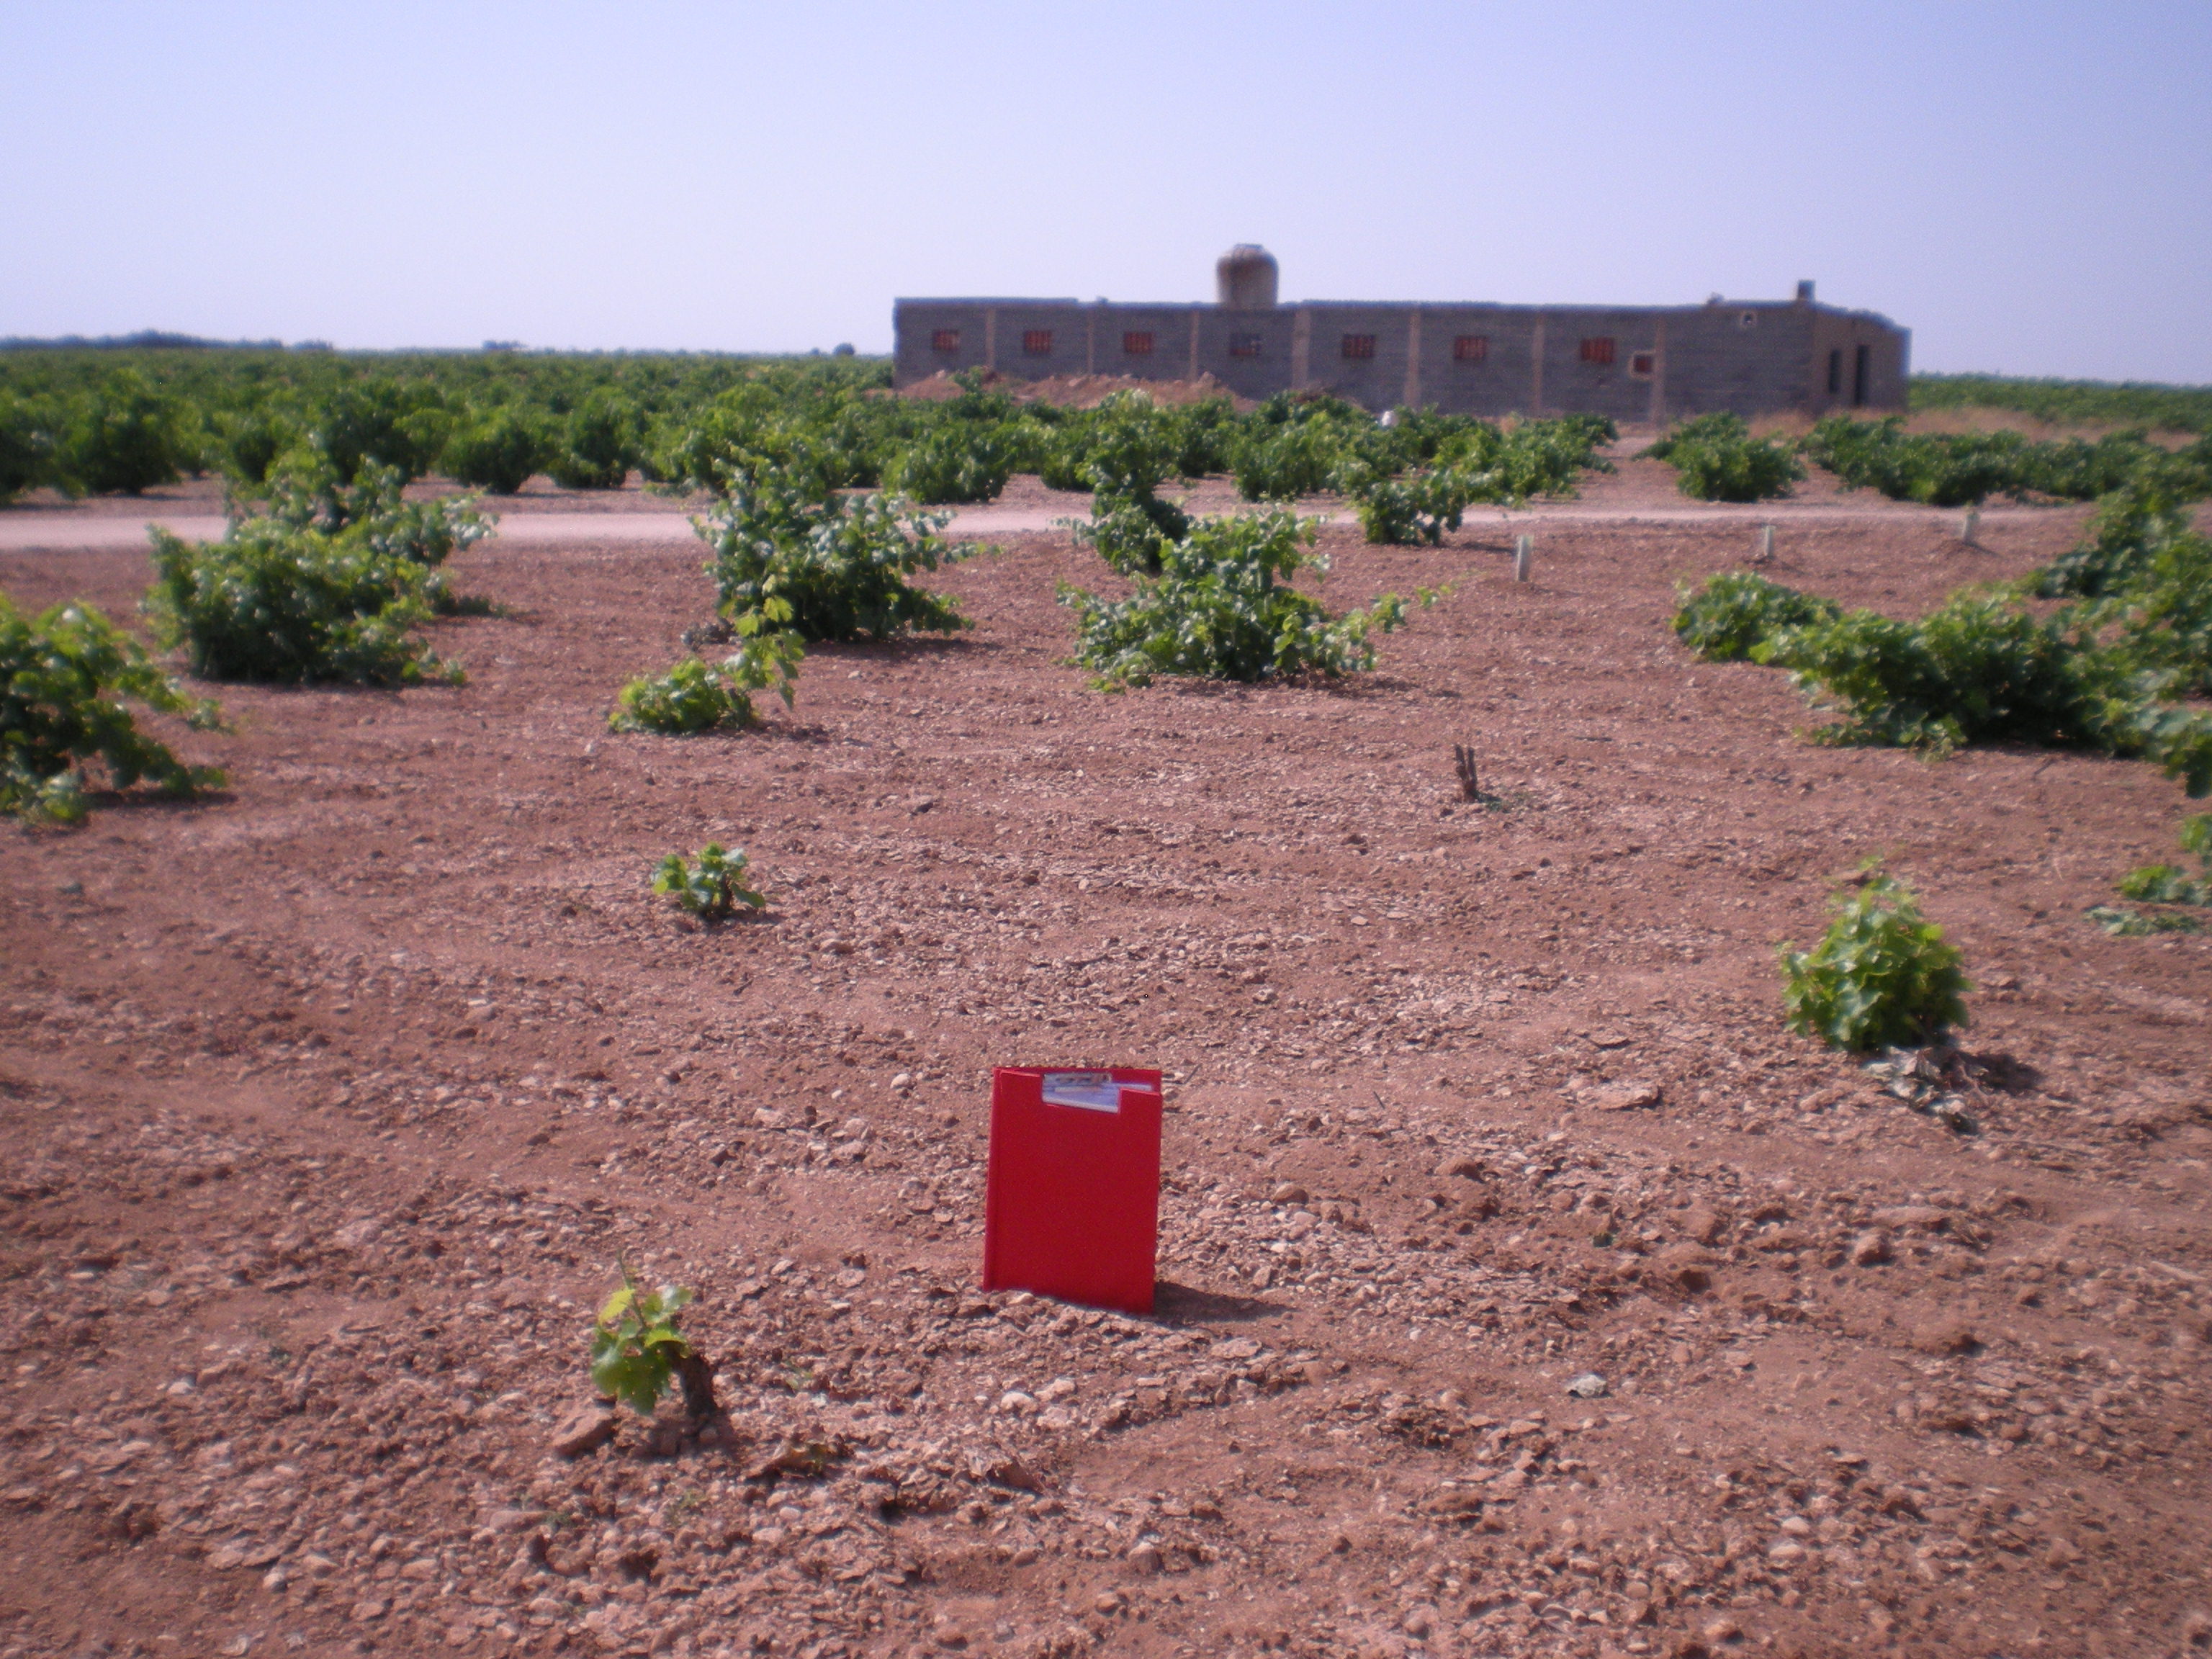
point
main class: Cropland
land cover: Vineyards
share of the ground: < 10 %
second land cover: Other bare soil
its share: > 75 %
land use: Agriculture (excluding fallow land and kitchen gardens)
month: June
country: ES
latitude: 39.6038
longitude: -3.2396
